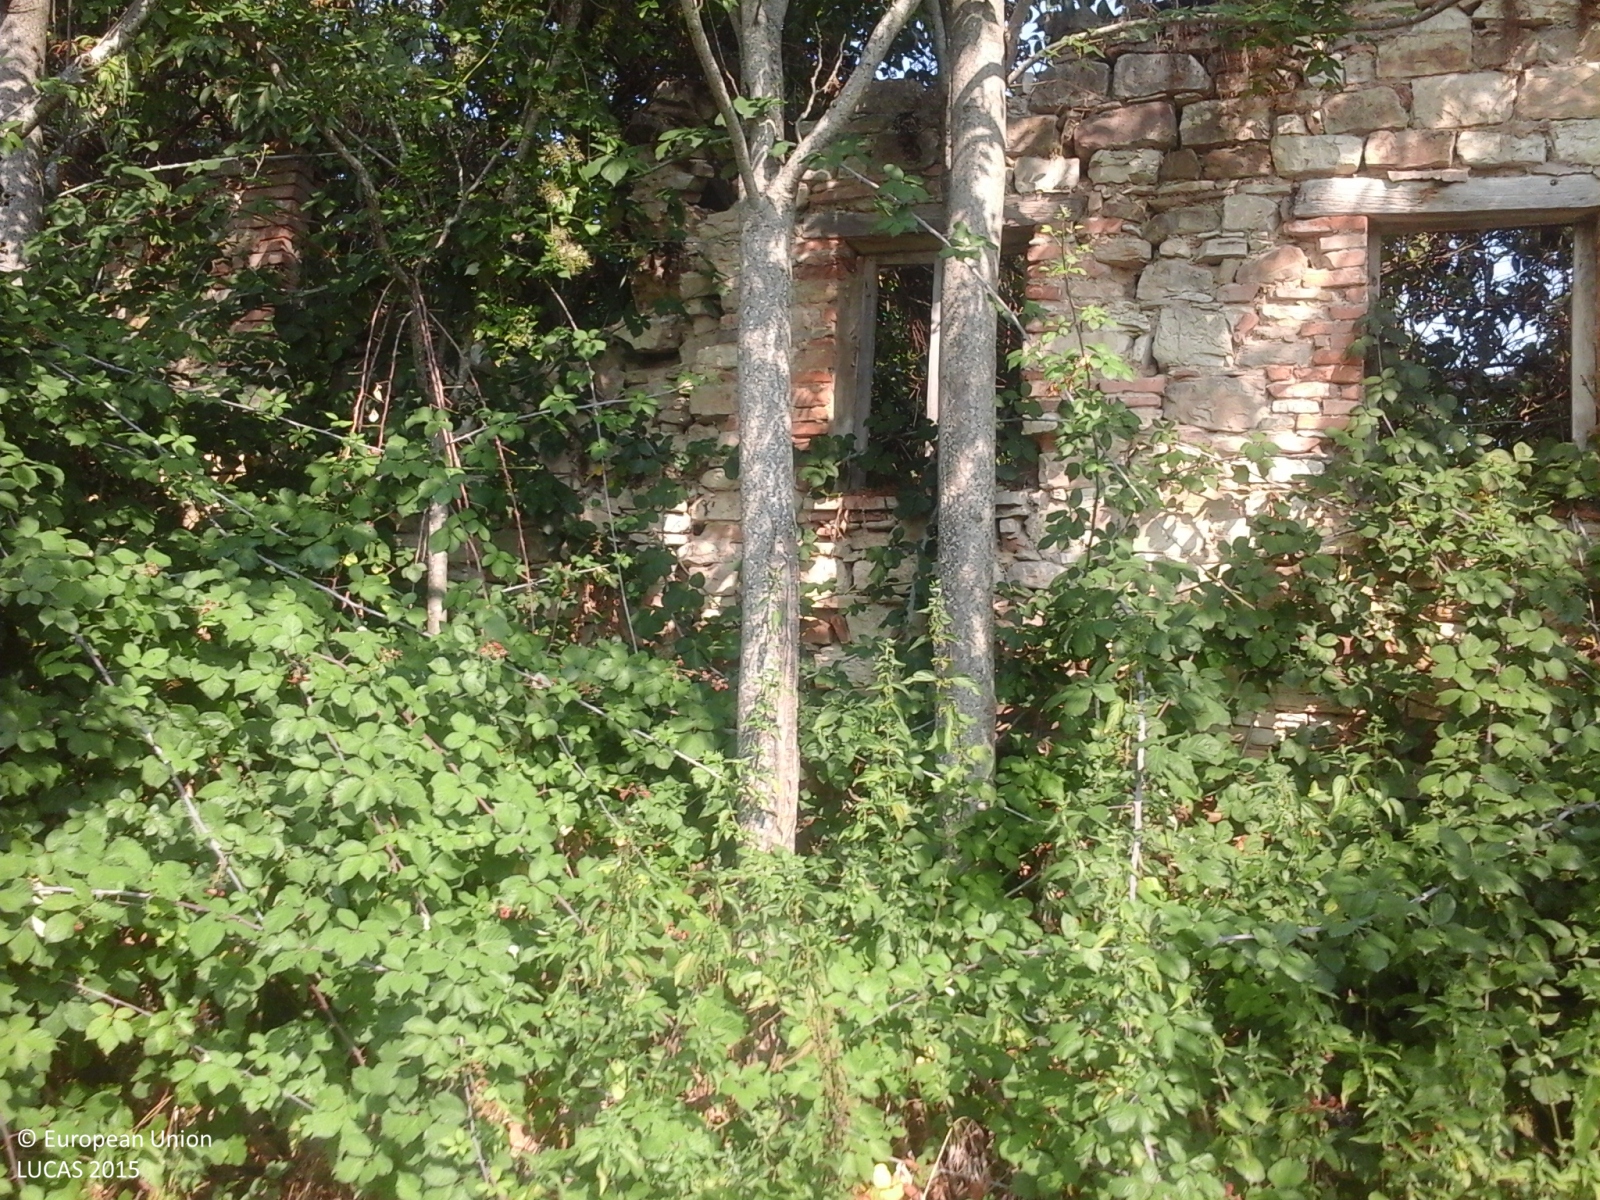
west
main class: Woodland
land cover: Broadleaved woodland
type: thermophilous deciduous forest
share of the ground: > 75 %
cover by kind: broadleaved forest trees 100 %
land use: Forestry
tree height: > 5 m
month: August
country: IT
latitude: 43.8171
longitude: 12.4185
